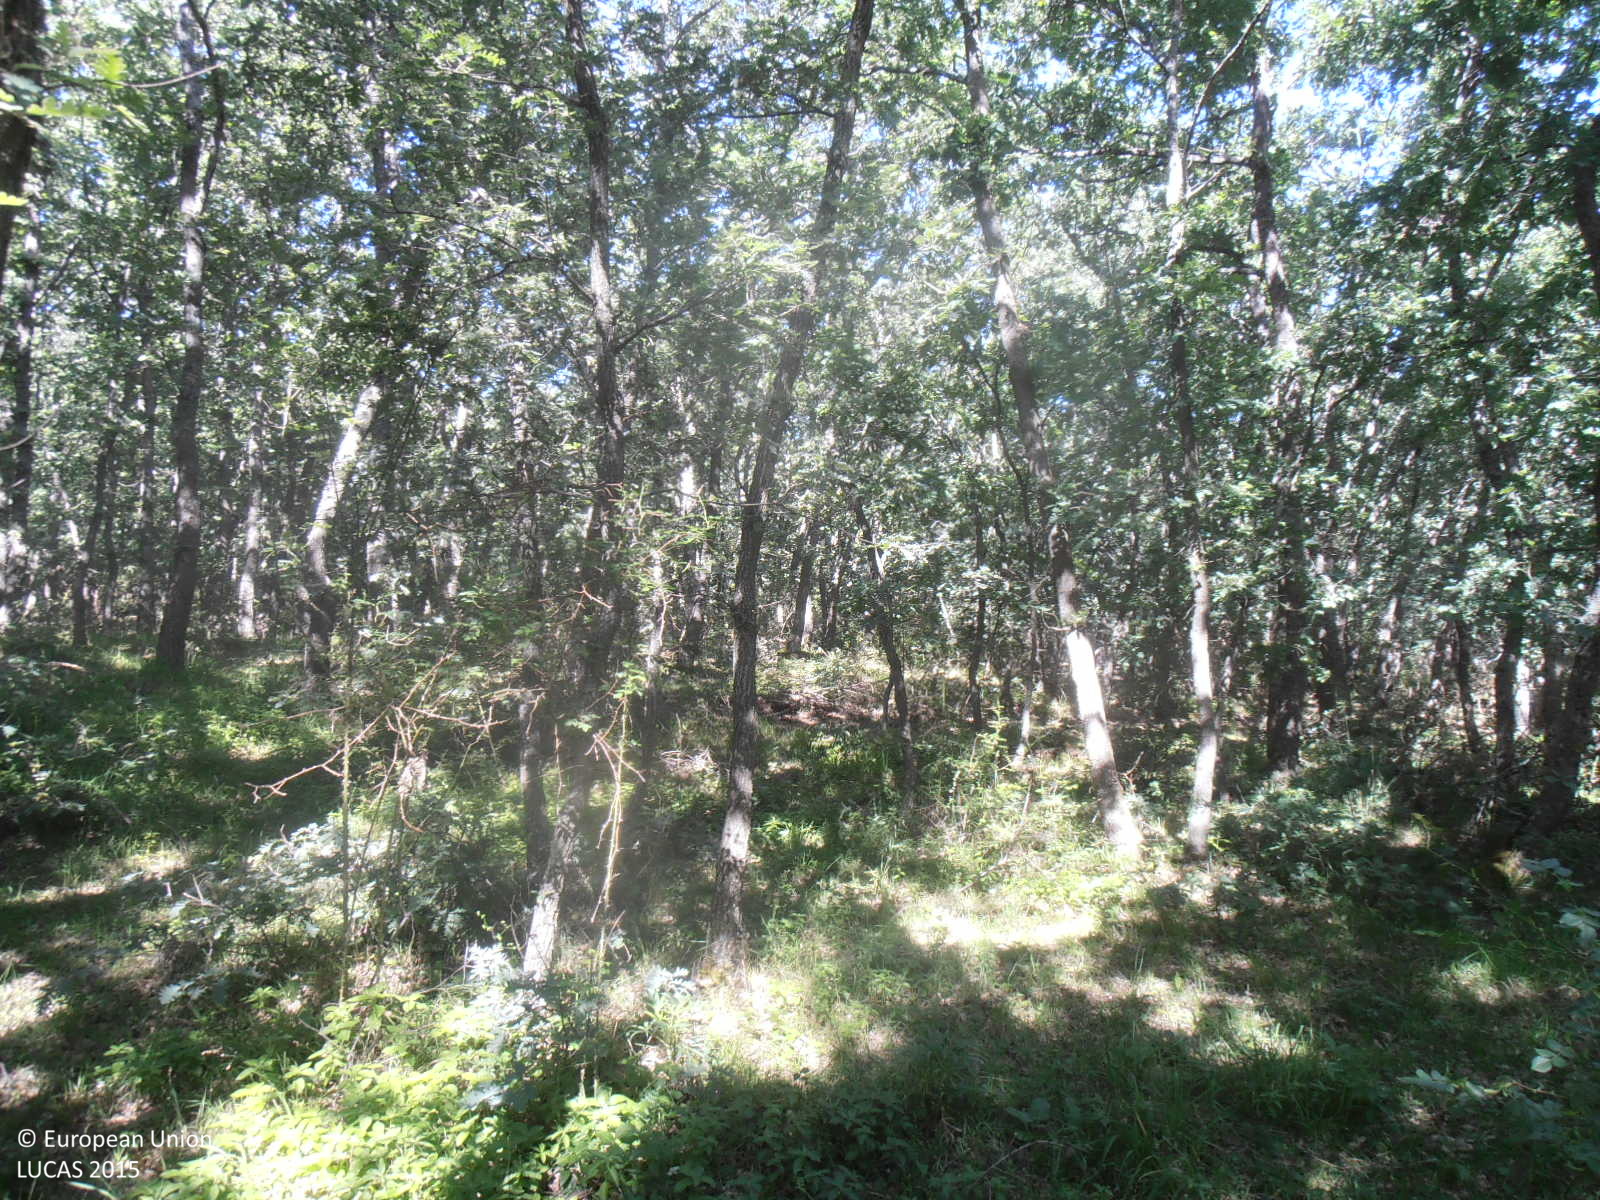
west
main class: Woodland
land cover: Broadleaved woodland
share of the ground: > 75 %
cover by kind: broadleaved forest trees 90 %, herbaceous plants 10 %
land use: Semi-natural and natural areas not in use
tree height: < 5 m
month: June
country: ES
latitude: 41.7584
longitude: -1.9758
